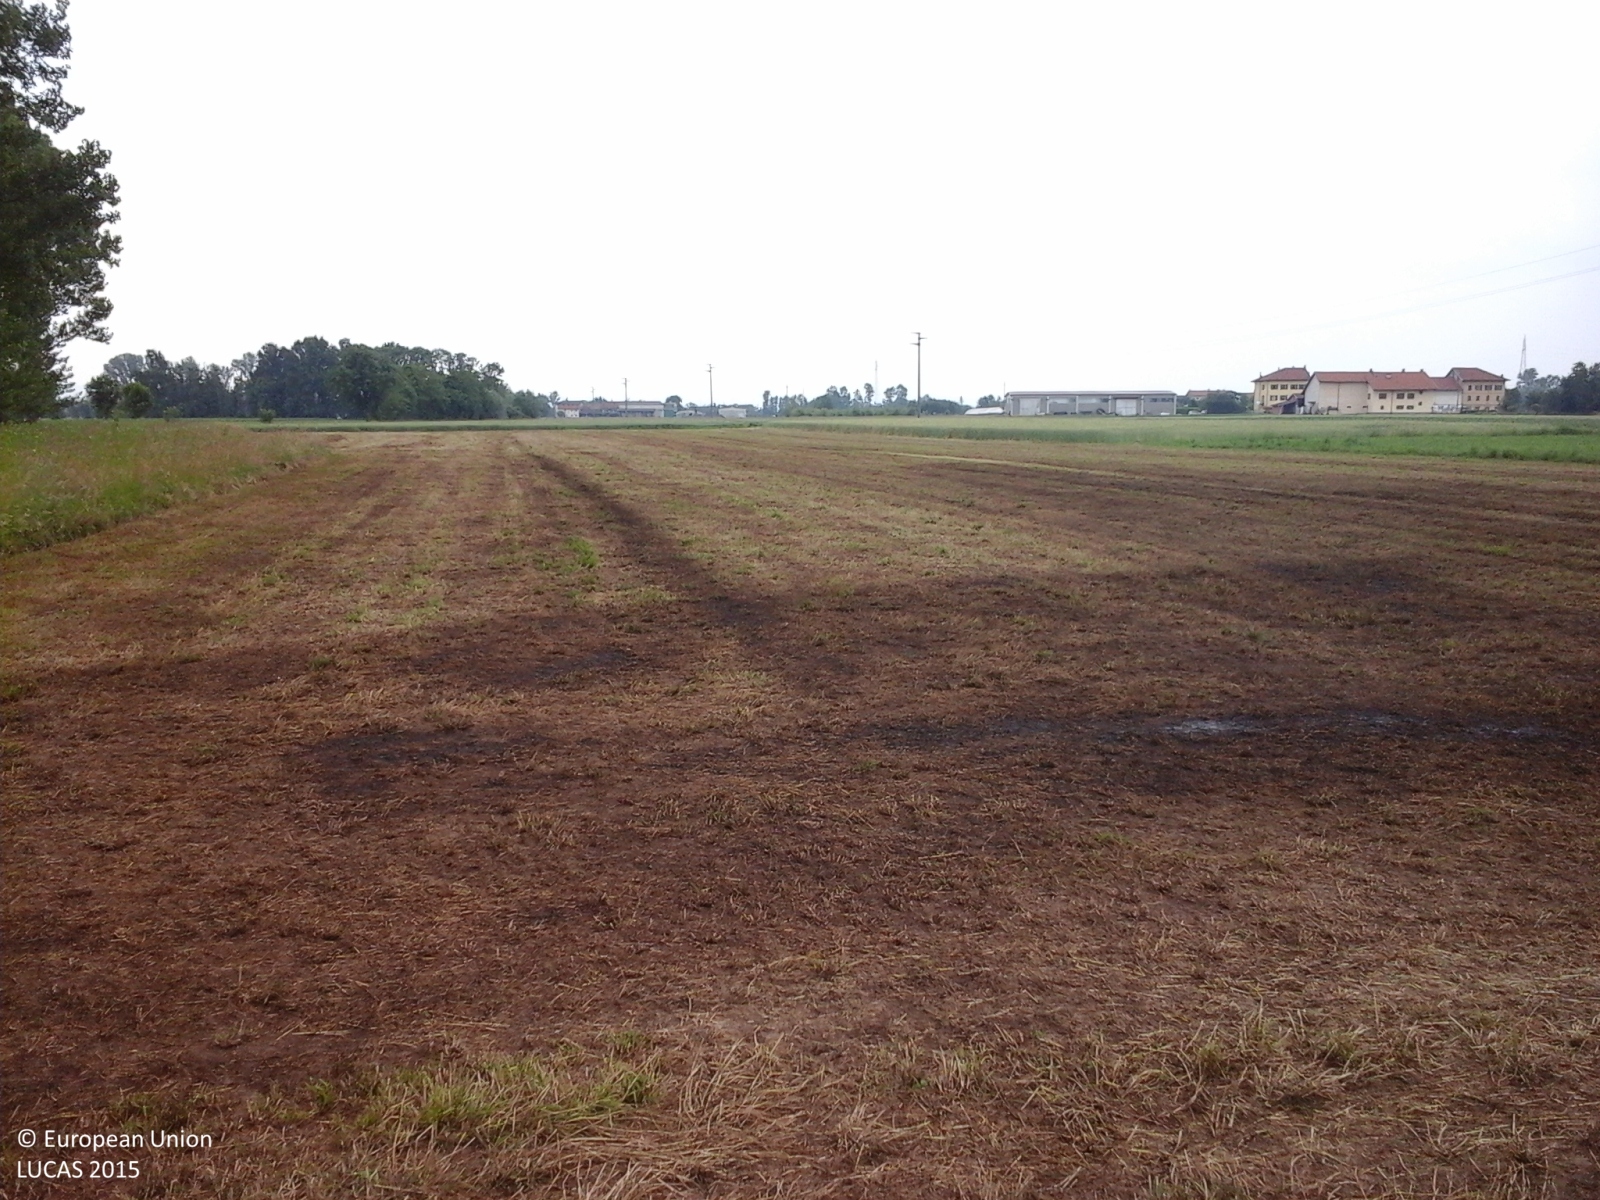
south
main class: Grassland
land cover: Grassland without tree/shrub cover
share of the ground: < 10 %
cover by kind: herbaceous plants 100 %
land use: Agriculture (excluding fallow land and kitchen gardens)
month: May
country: IT
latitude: 45.3547
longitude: 7.7698
